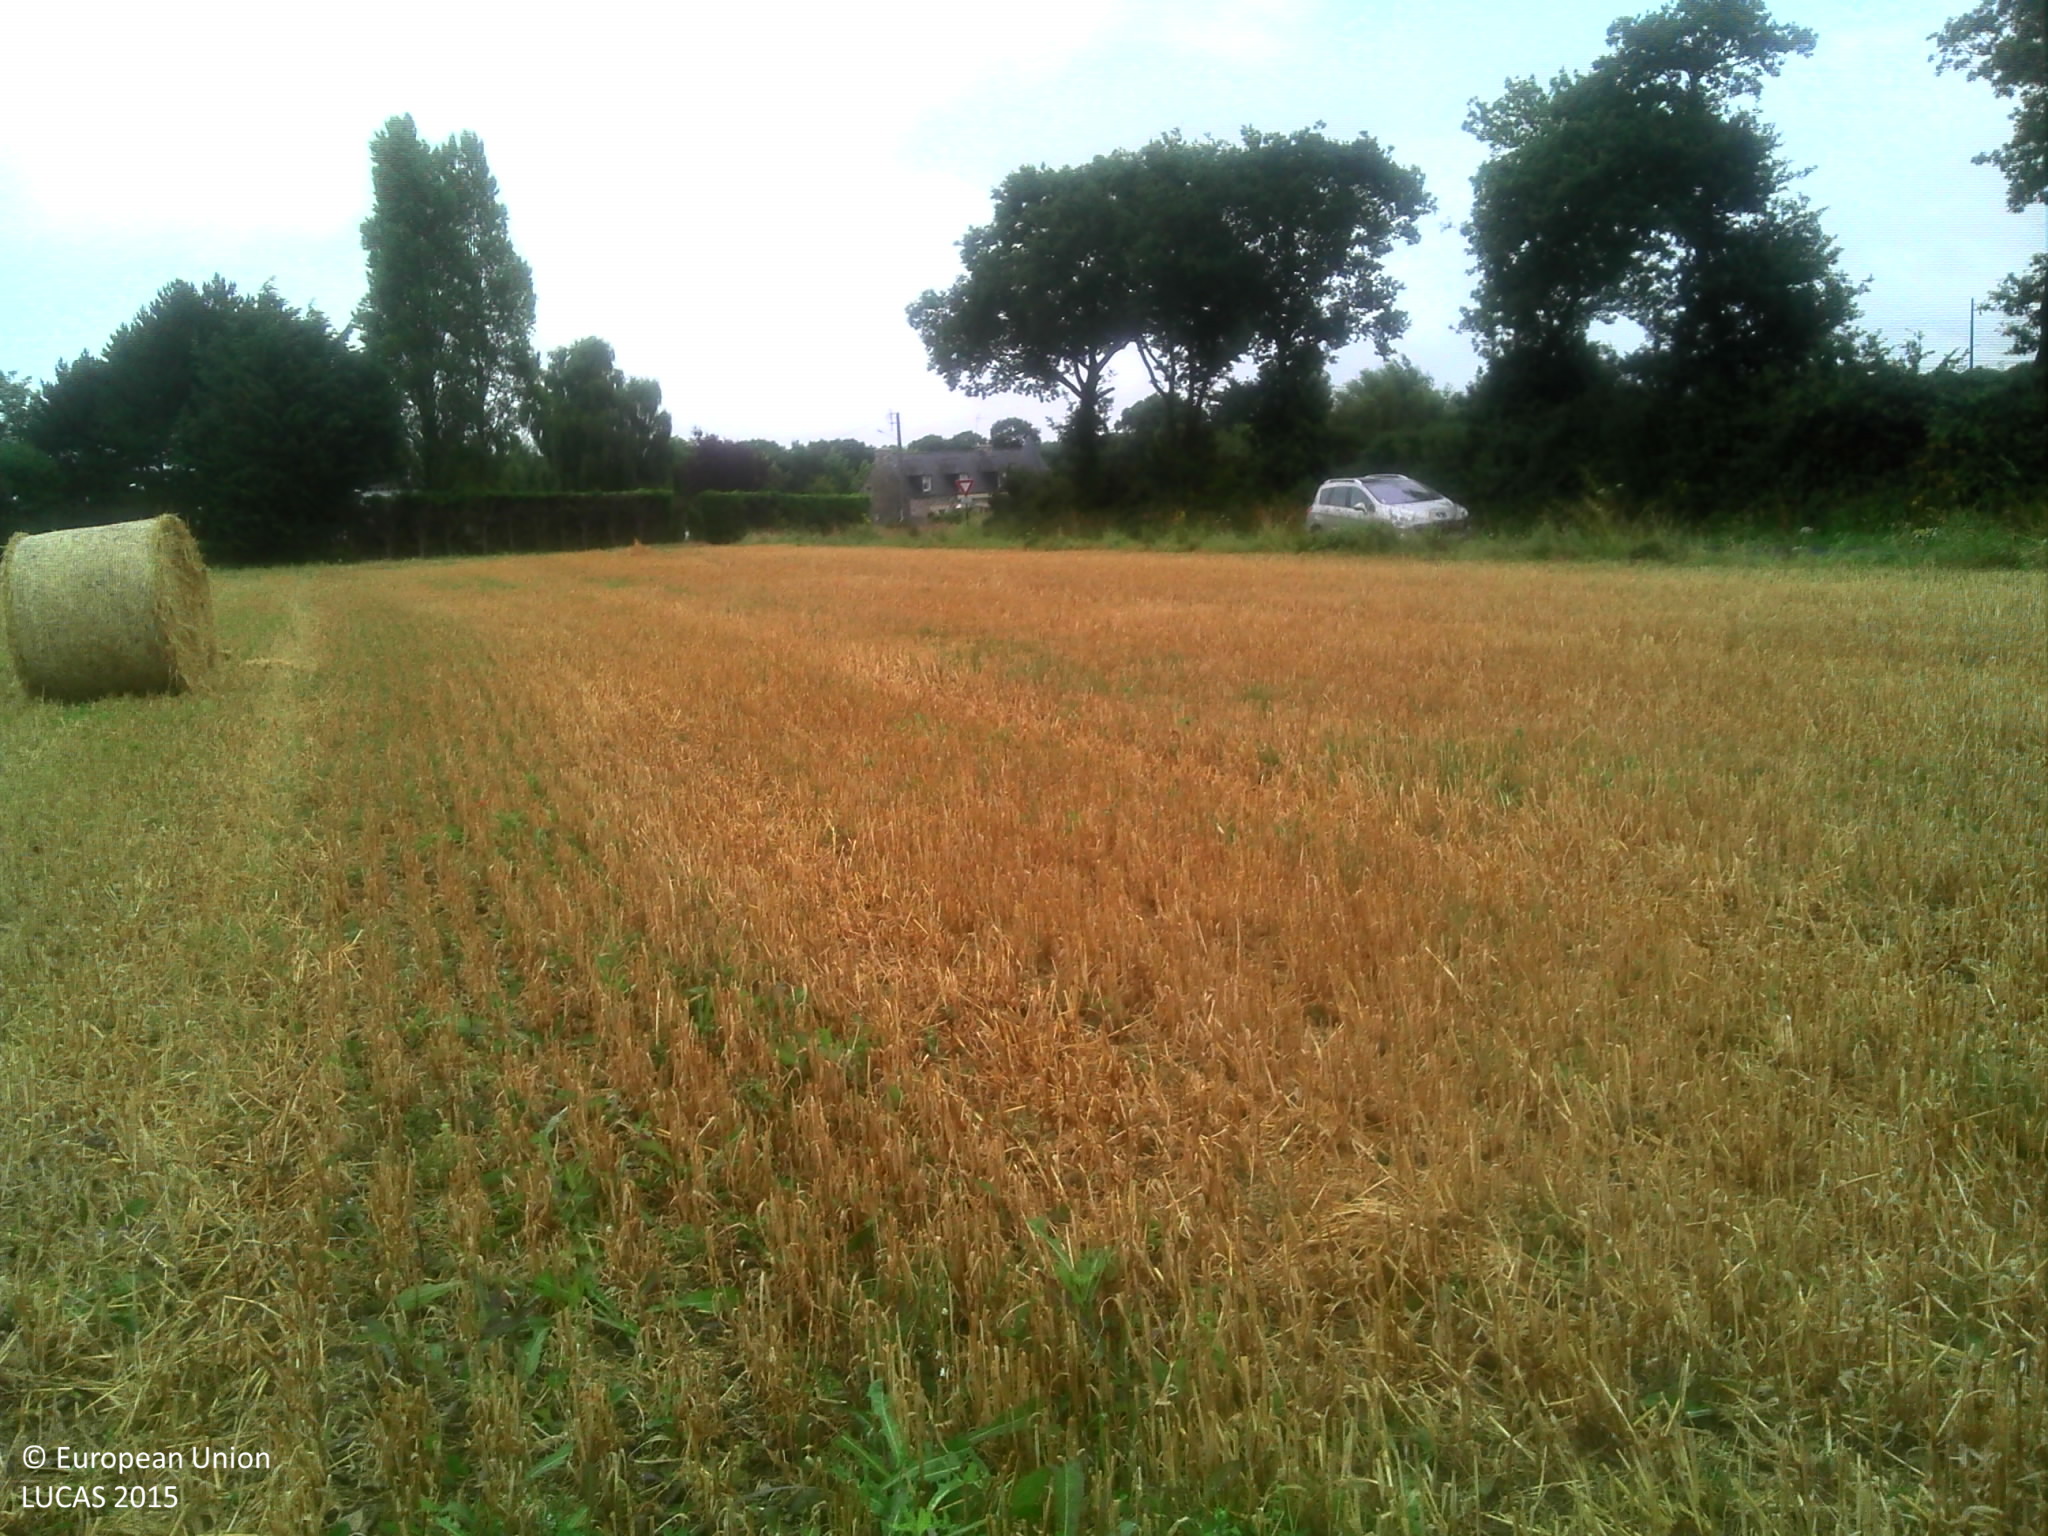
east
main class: Cropland
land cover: Barley
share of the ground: > 75 %
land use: Agriculture (excluding fallow land and kitchen gardens)
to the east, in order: Barley; Grass margins; Ditches and canals; Grass margins; Paved roads, cycling and walking lanes; Grass margins; Ditches and canals; Lines of trees; Durum wheat; Electric lines; Abandoned hedges; Ditches and canals; Grass margins; Paved roads, cycling and walking lanes; Grass margins; Ditches and canals; Grass margins; Rape and turnip rape; Abandoned hedges; Ditches and canals; Grass margins; Paved roads, cycling and walking lanes; Grass margins; Ditches and canals; Electric lines; Grass margins; Rape and turnip rape
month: July
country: FR
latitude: 48.5807
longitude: -2.5195
